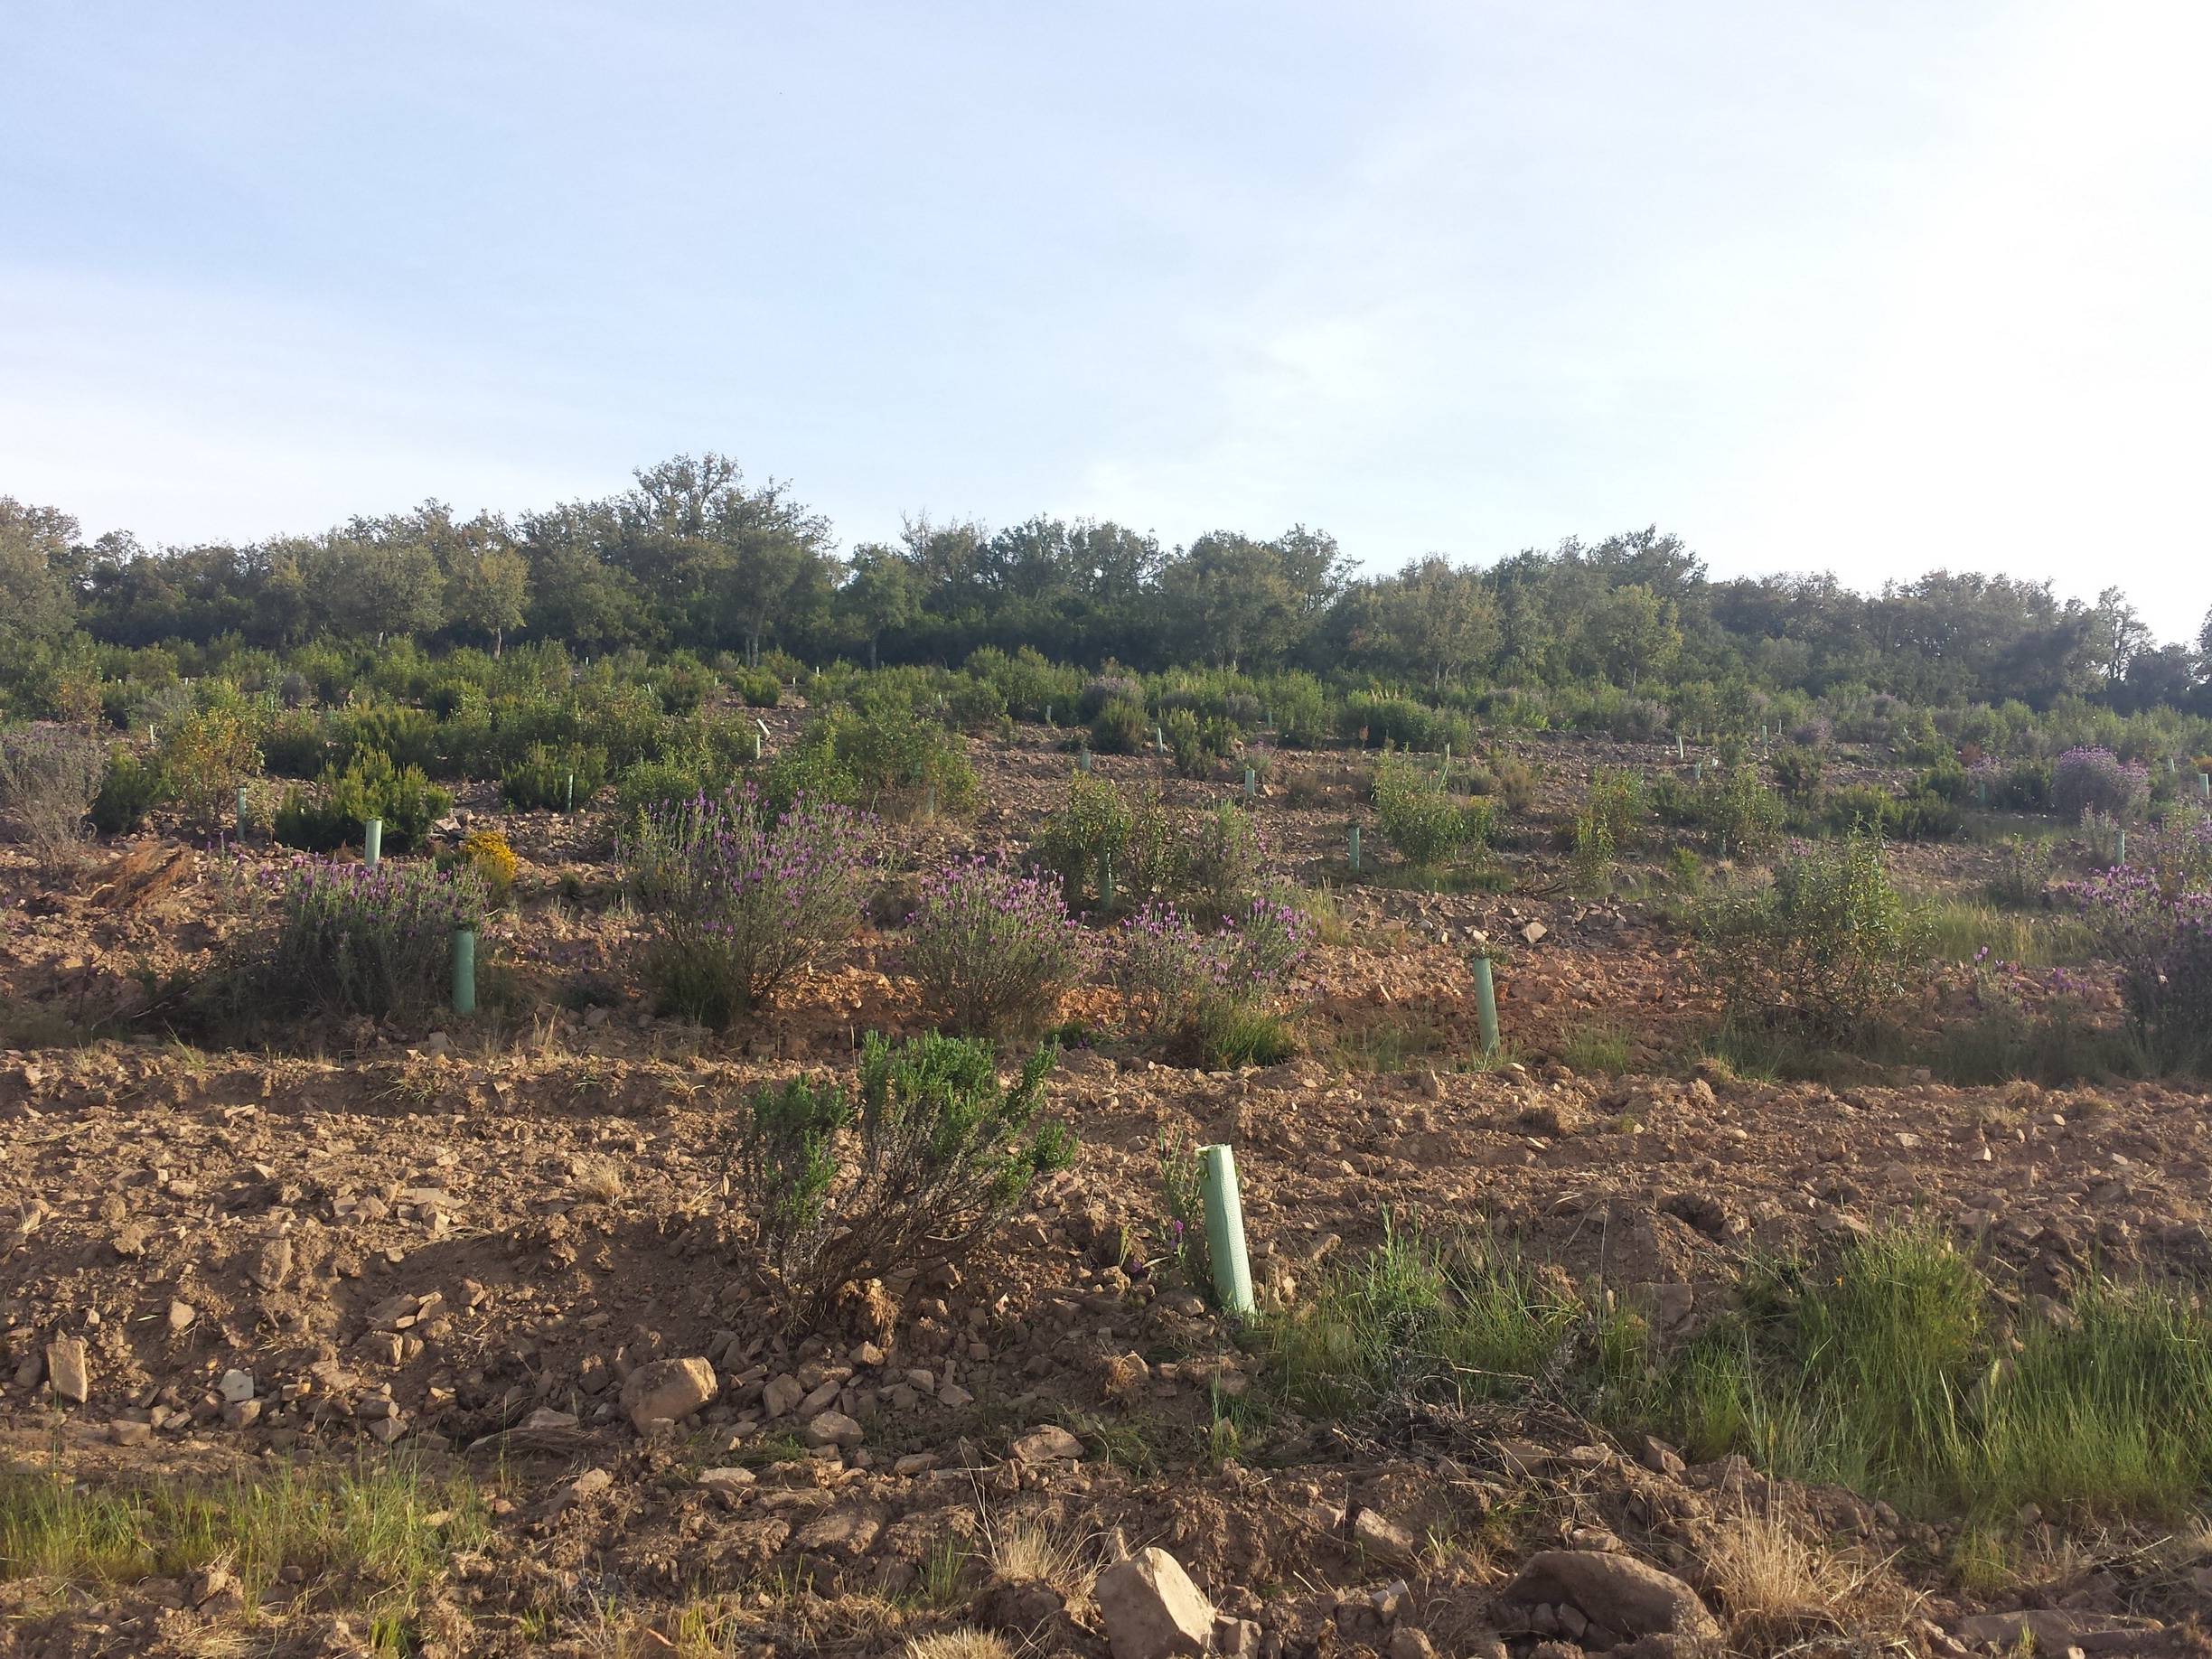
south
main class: Shrubland
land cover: Shrubland without tree cover
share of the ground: 10 - 25 %
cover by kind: unconsolidated bare surface 70 %, shrubs 15 %, herbaceous plants 15 %
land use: Forestry
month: May
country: ES
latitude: 39.5856
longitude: -7.1915
